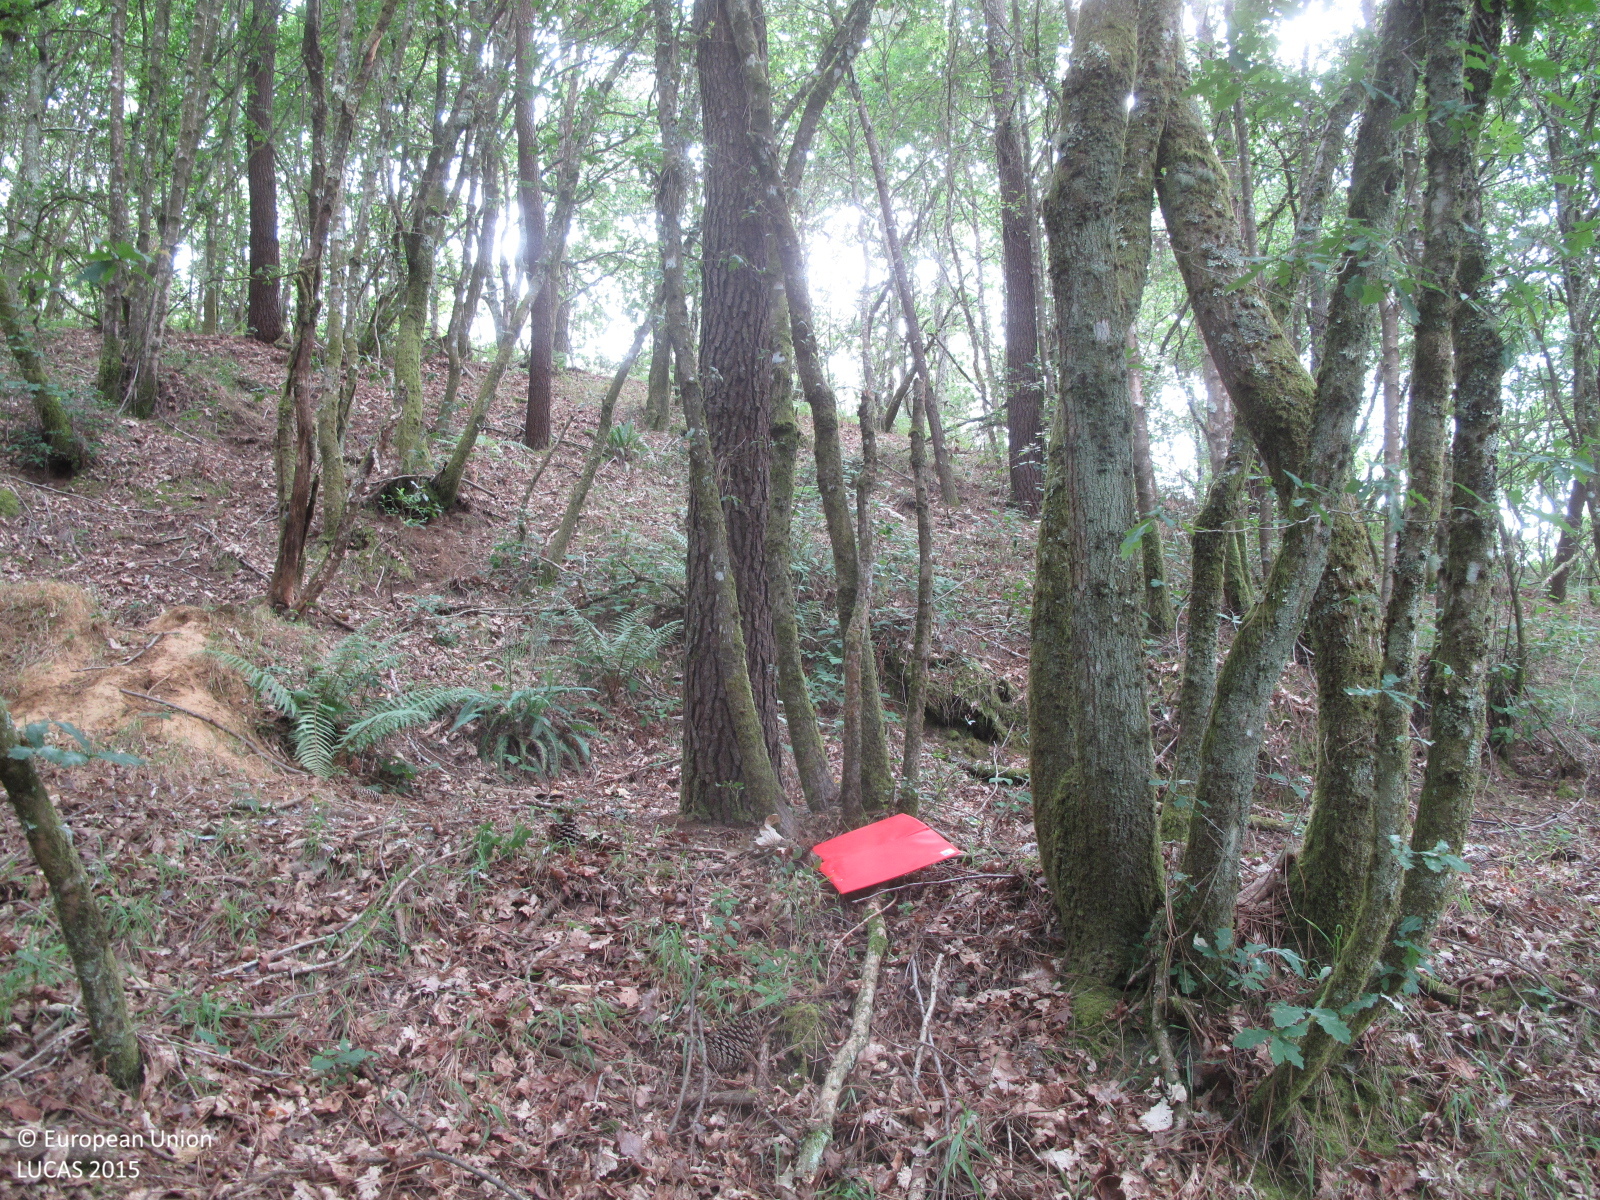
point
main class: Woodland
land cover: Broadleaved woodland
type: acidophilous oak and oak-birch forest
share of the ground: > 75 %
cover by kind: broadleaved forest trees 90 %, herbaceous plants 10 %
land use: Forestry
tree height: > 5 m
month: July
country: ES
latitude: 43.2123
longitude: -8.2563
